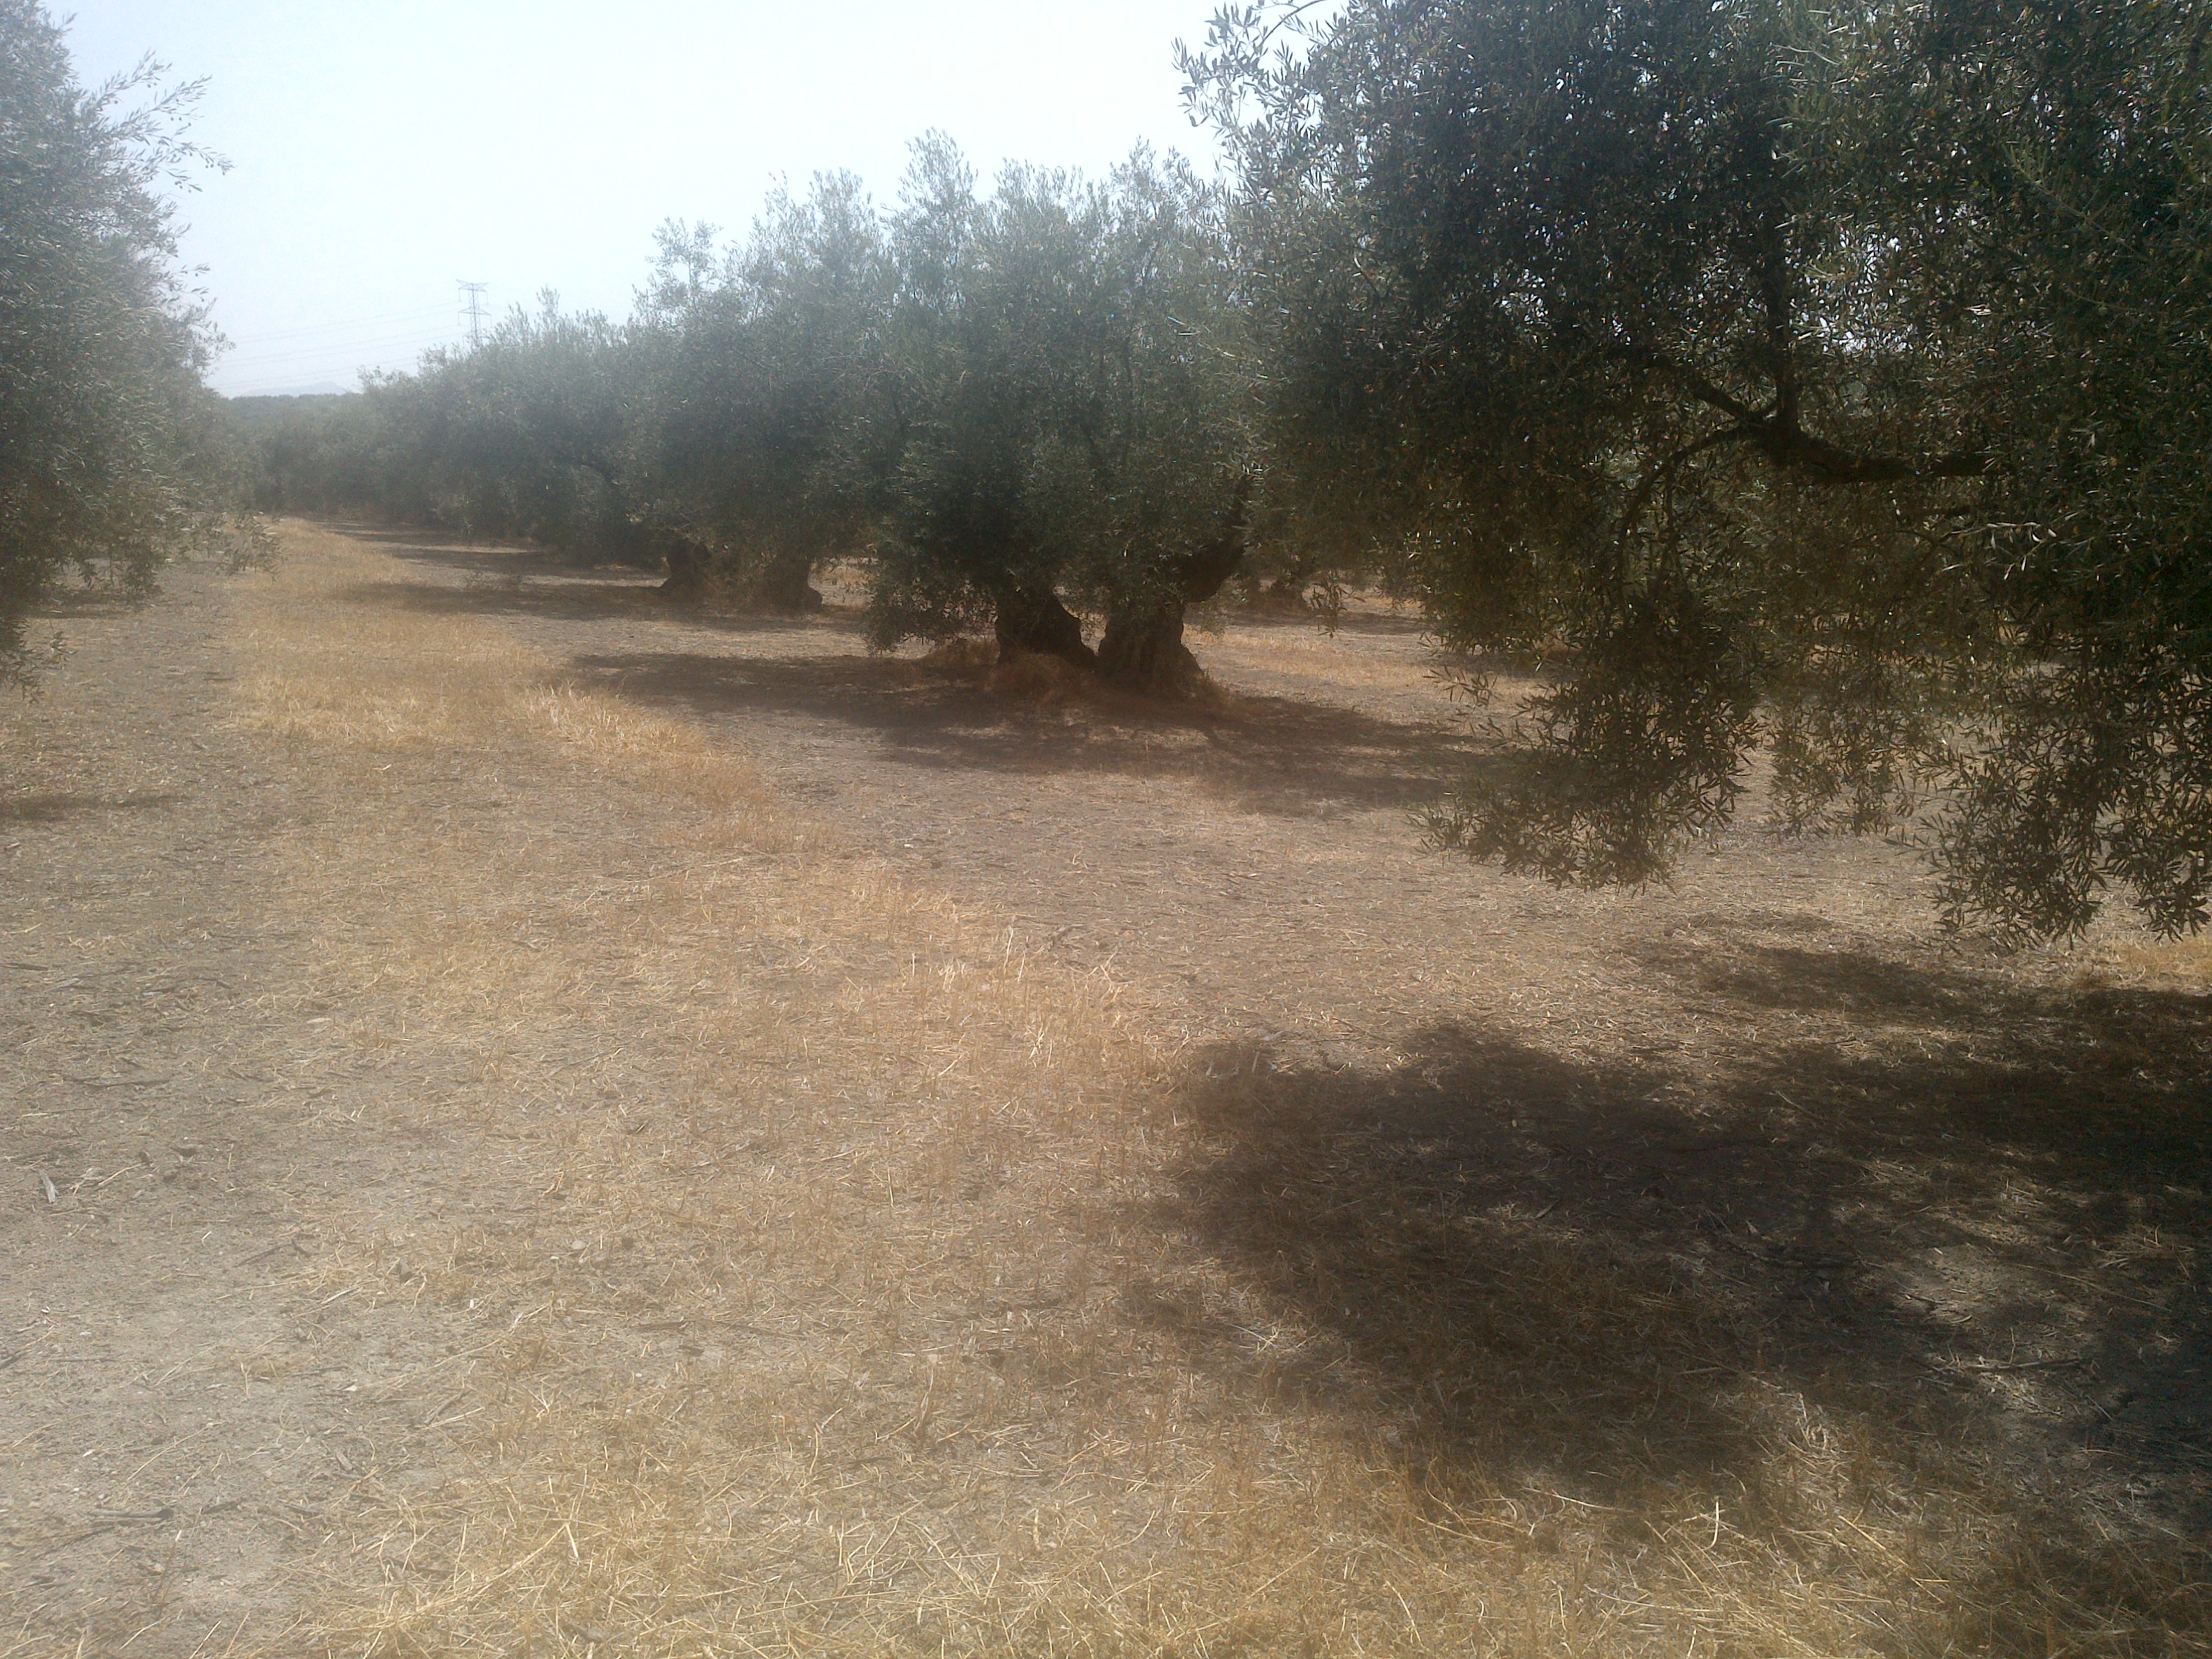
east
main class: Cropland
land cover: Olive groves
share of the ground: 50 - 75 %
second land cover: Spontaneously vegetated surfaces
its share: 10 - 25 %
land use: Agriculture (excluding fallow land and kitchen gardens)
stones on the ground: < 10 %
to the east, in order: Olive groves; Spontaneously vegetated surfaces; Ditches and canals; Tracks; Grass margins; Olive groves
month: July
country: ES
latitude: 37.4280
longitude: -4.5705
